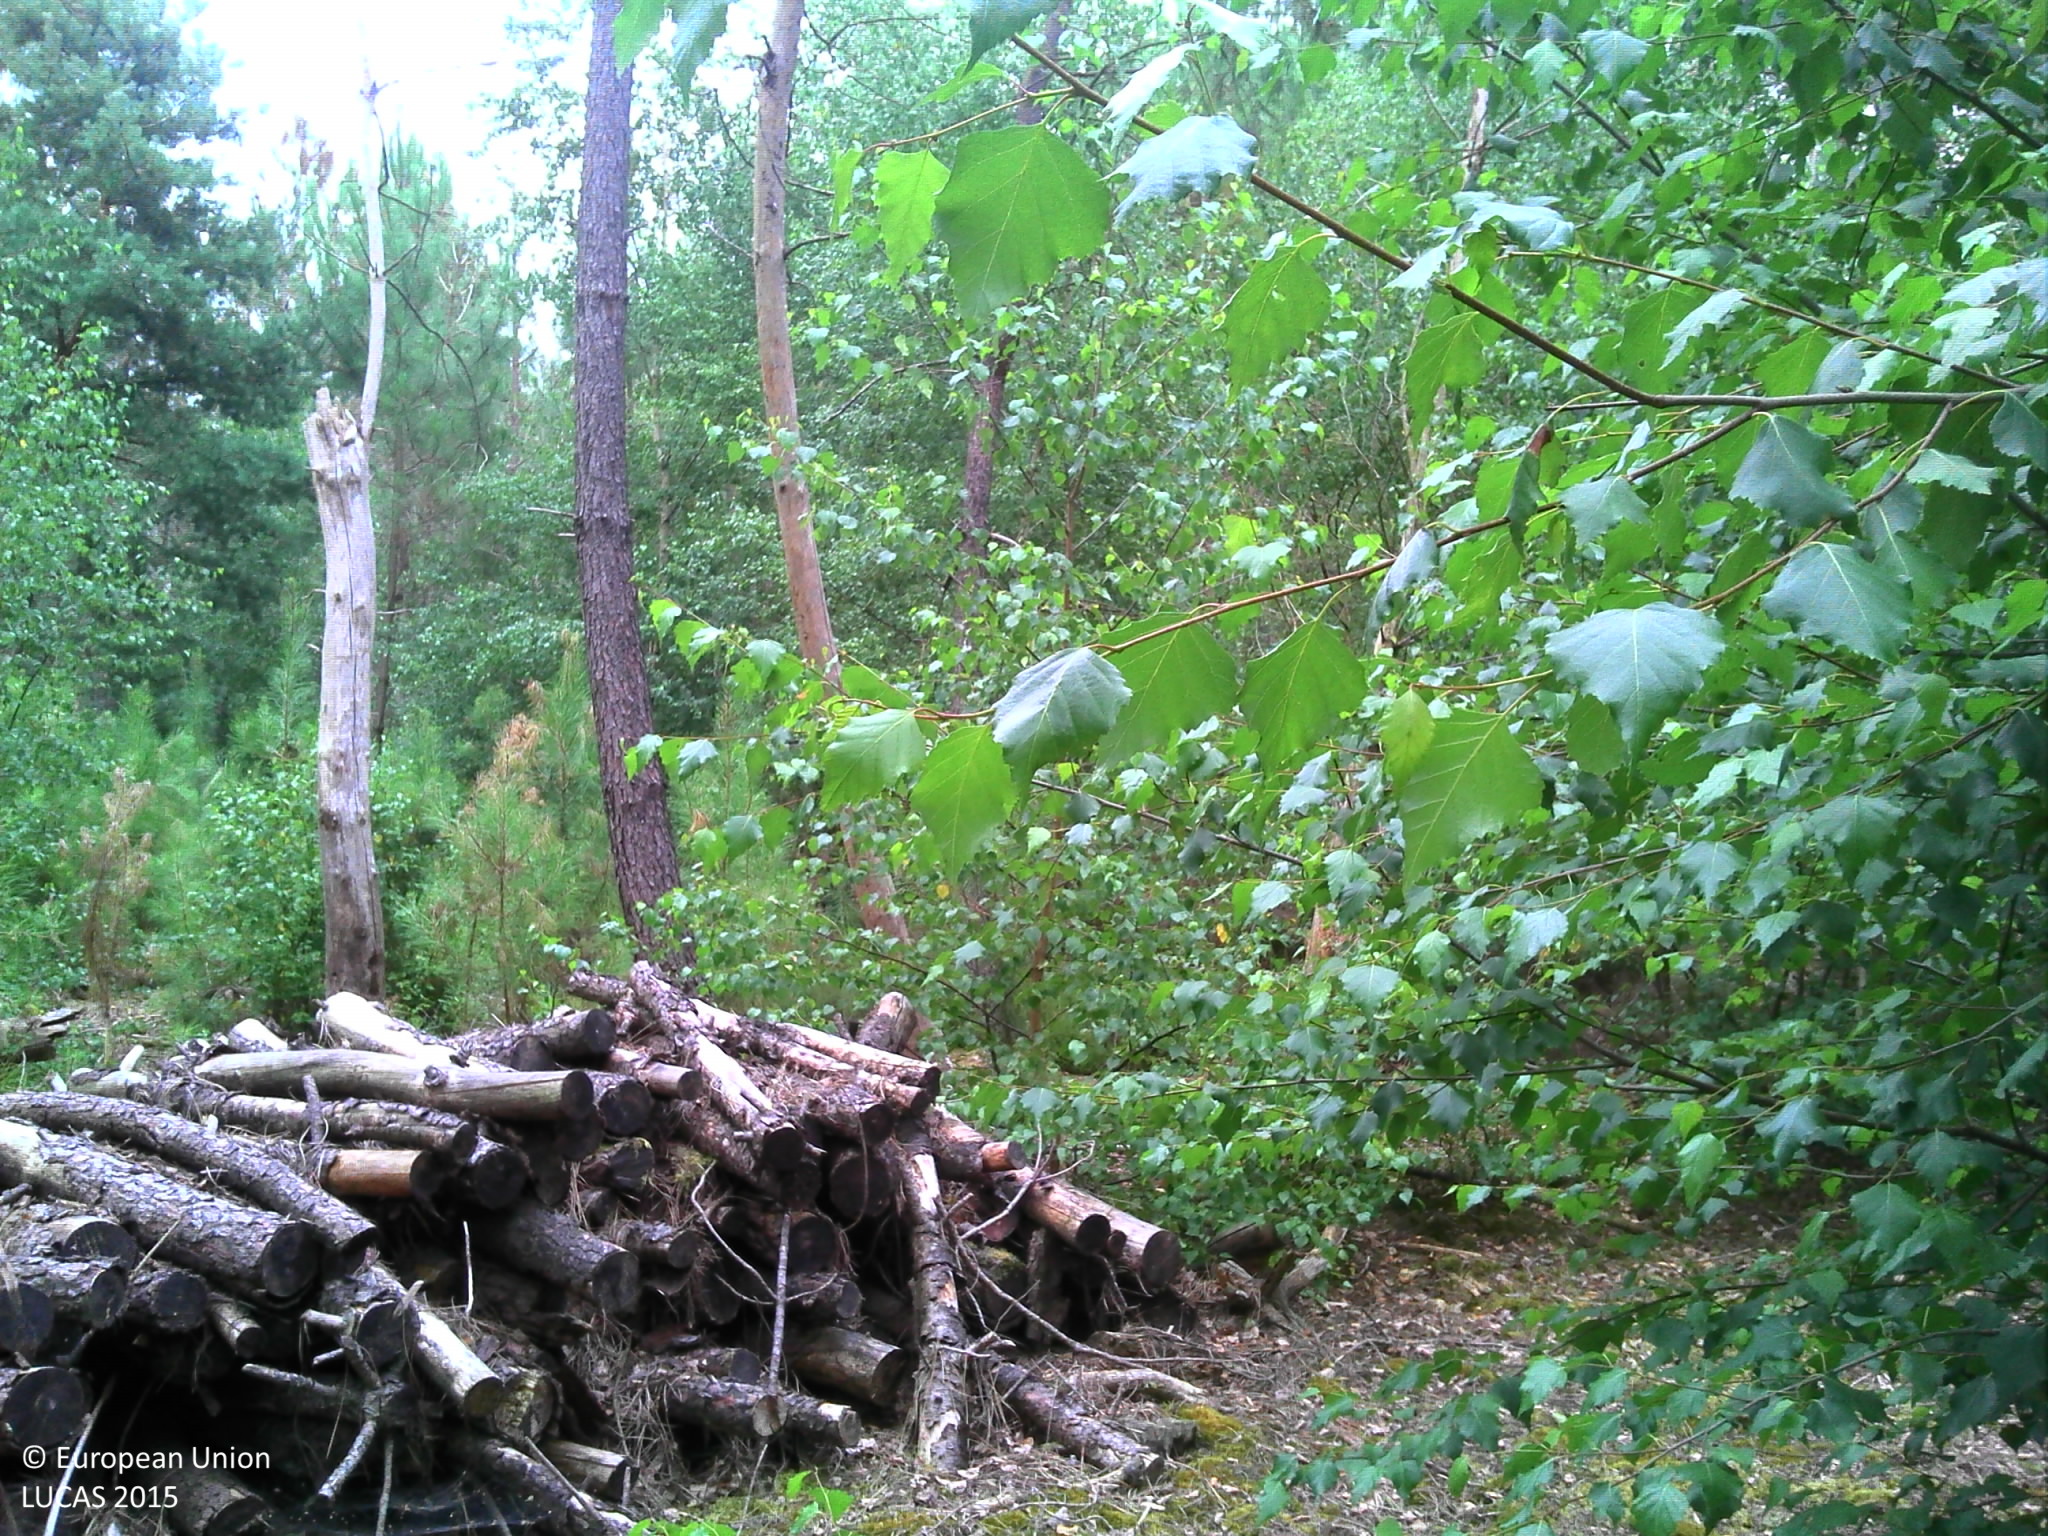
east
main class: Woodland
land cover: Pine dominated coniferous woodland
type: exotic forest
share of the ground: > 75 %
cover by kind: coniferous forest trees 60 %, herbaceous plants 30 %, shrubs 10 %
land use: Forestry
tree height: > 5 m
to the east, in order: Pine dominated coniferous woodland; Tracks; Fences; Pine dominated coniferous woodland
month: July
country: FR
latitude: 47.8884
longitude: 0.3331
